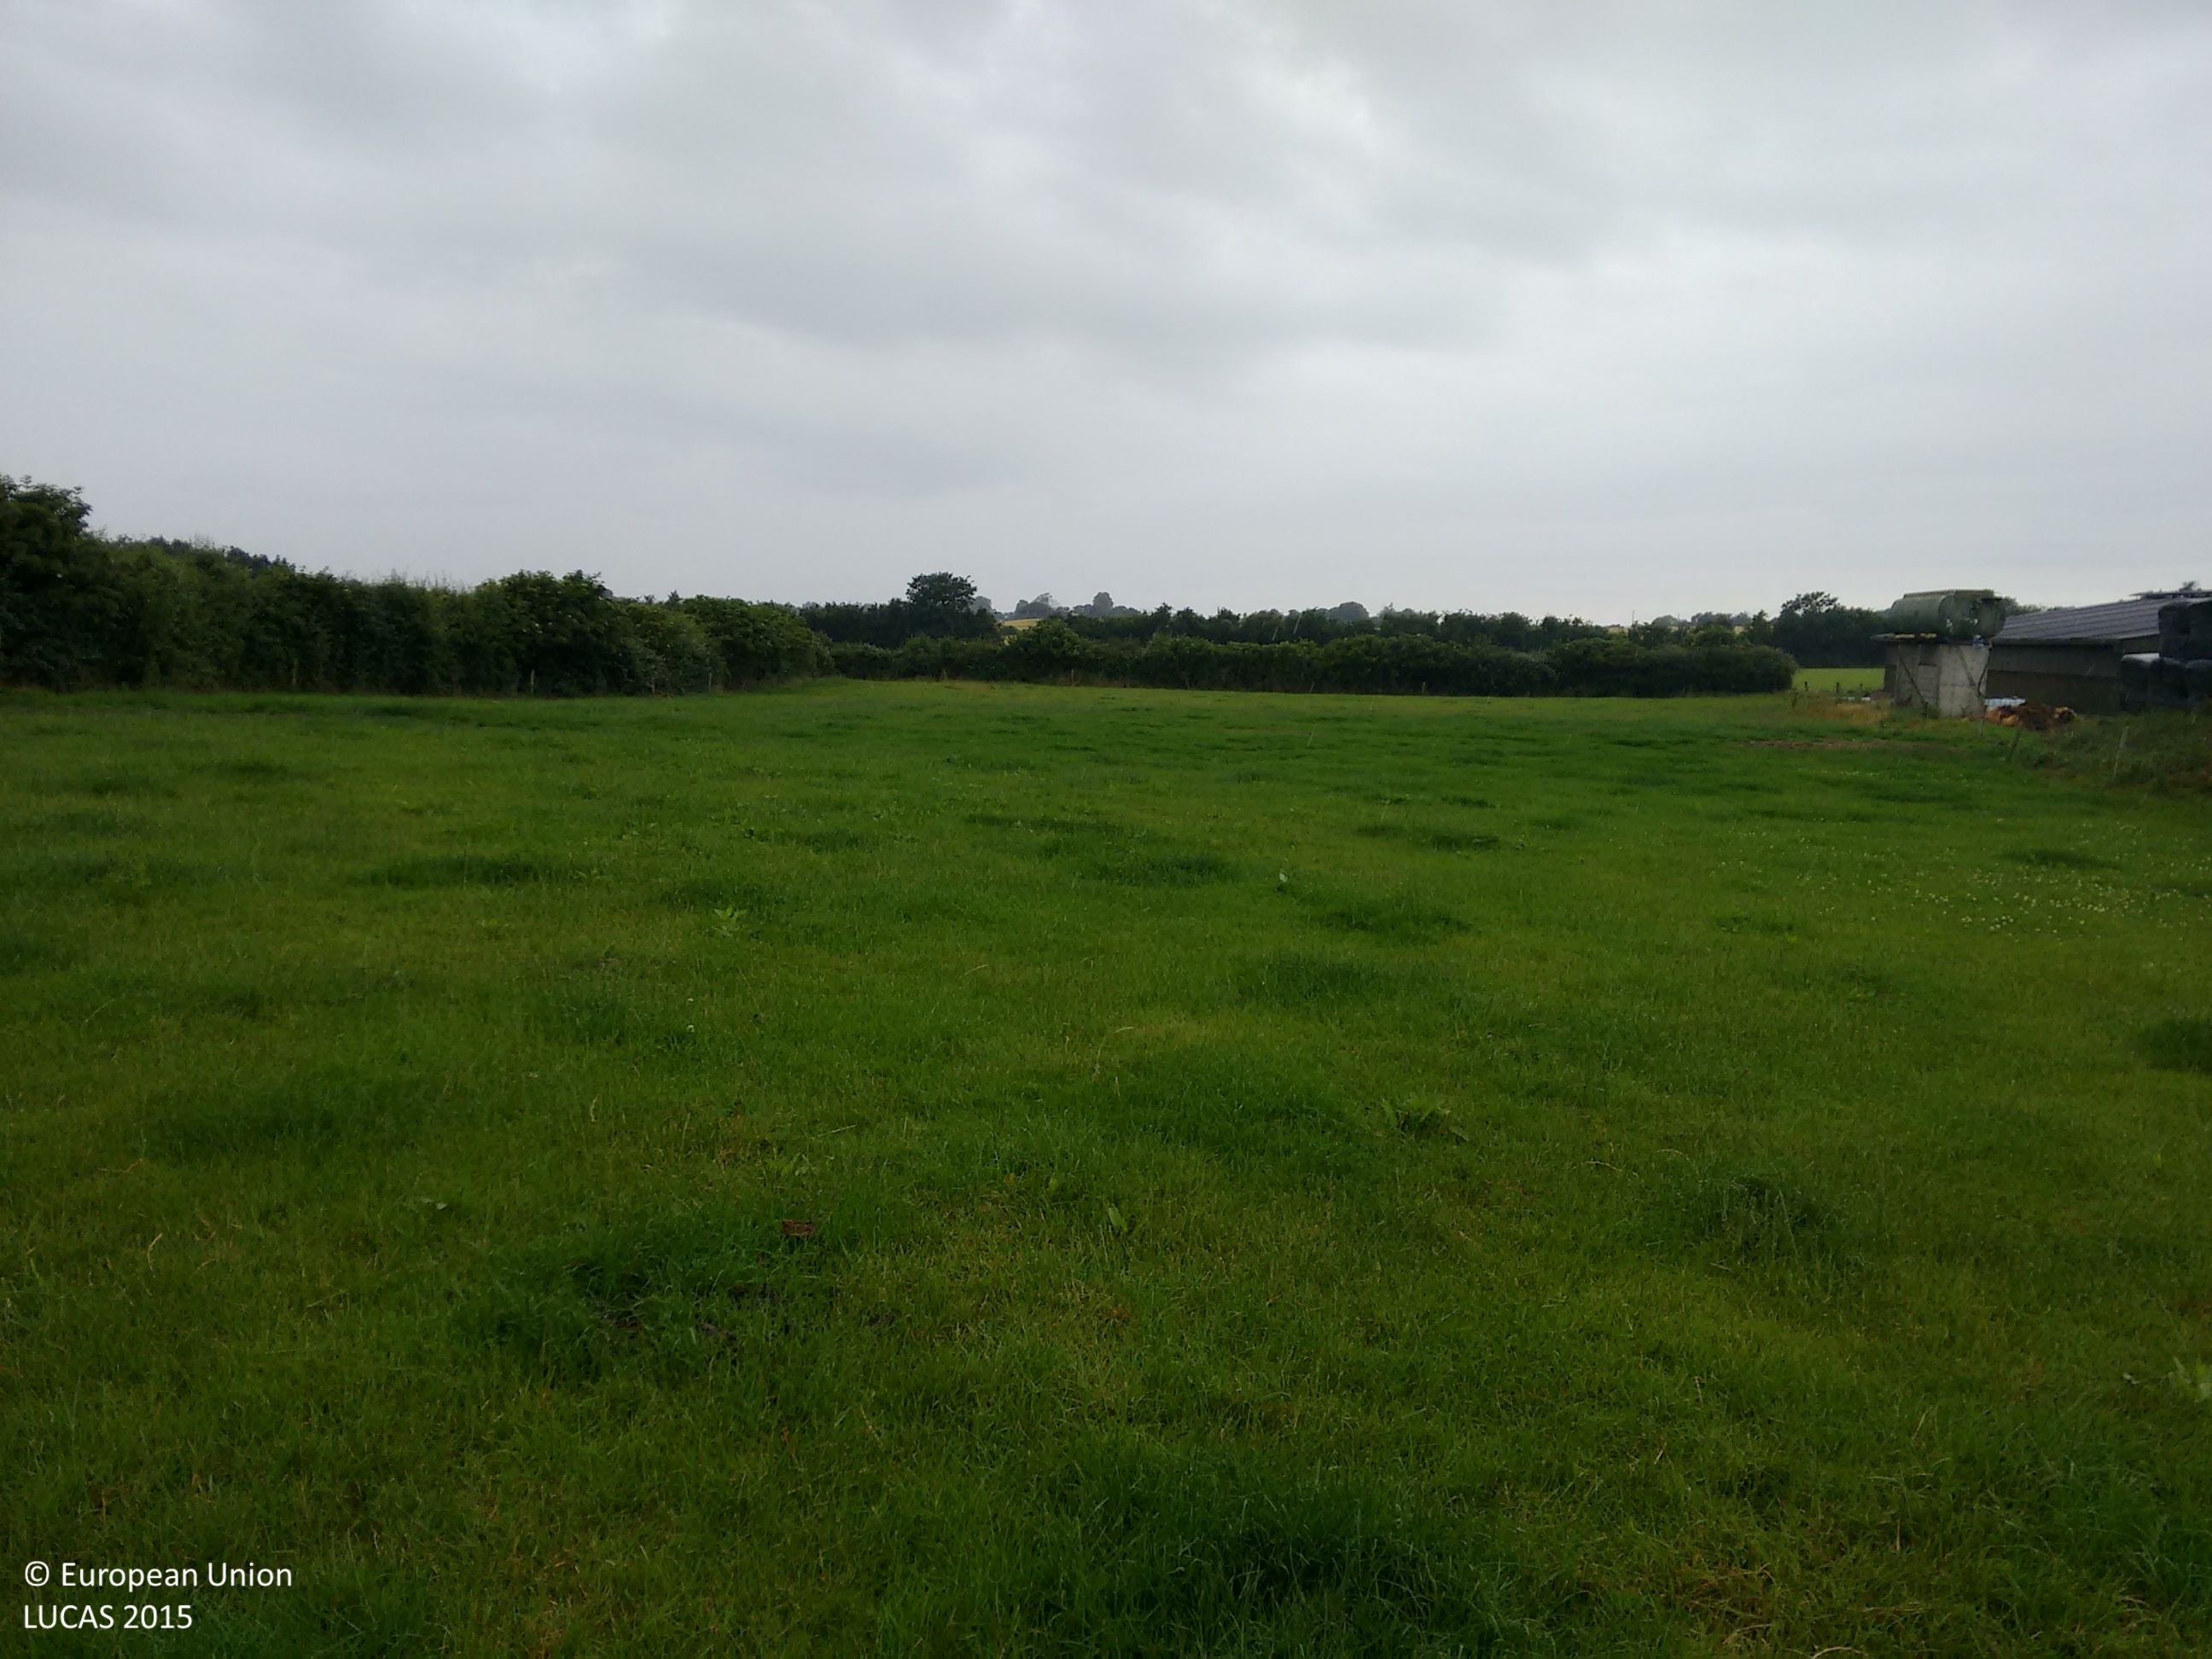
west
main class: Grassland
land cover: Grassland without tree/shrub cover
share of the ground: > 75 %
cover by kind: herbaceous plants 100 %
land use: Agriculture (excluding fallow land and kitchen gardens)
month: July
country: IE
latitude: 52.5947
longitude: -7.2304
